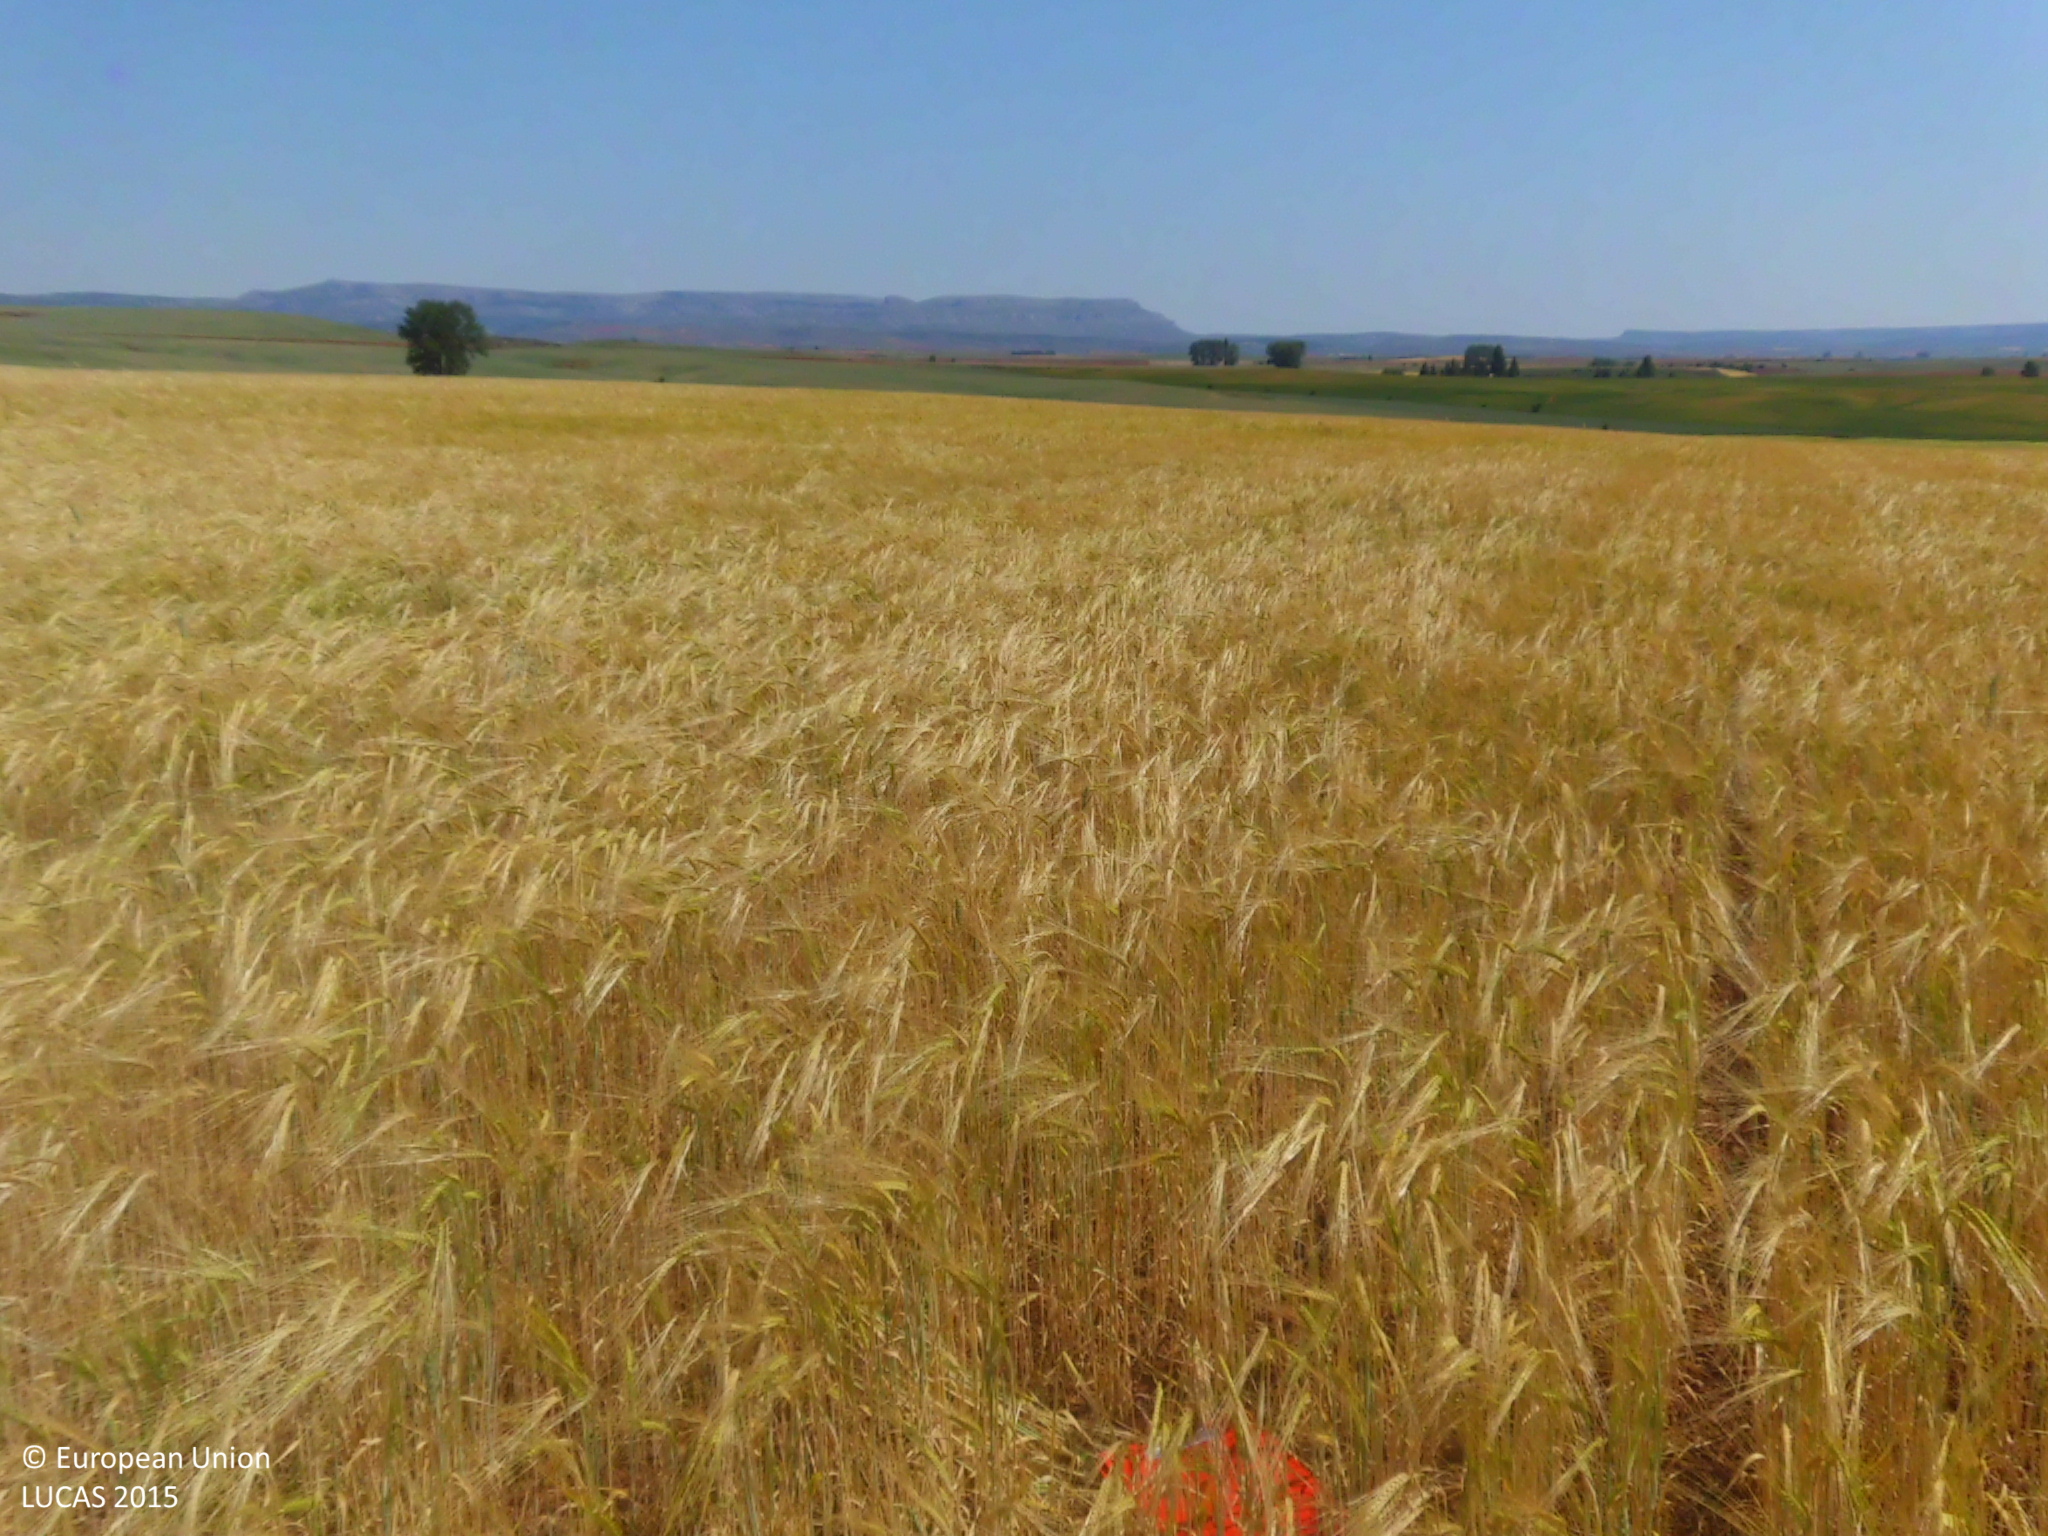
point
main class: Cropland
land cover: Barley
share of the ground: > 75 %
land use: Agriculture (excluding fallow land and kitchen gardens)
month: June
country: ES
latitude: 42.5402
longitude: -4.2323
